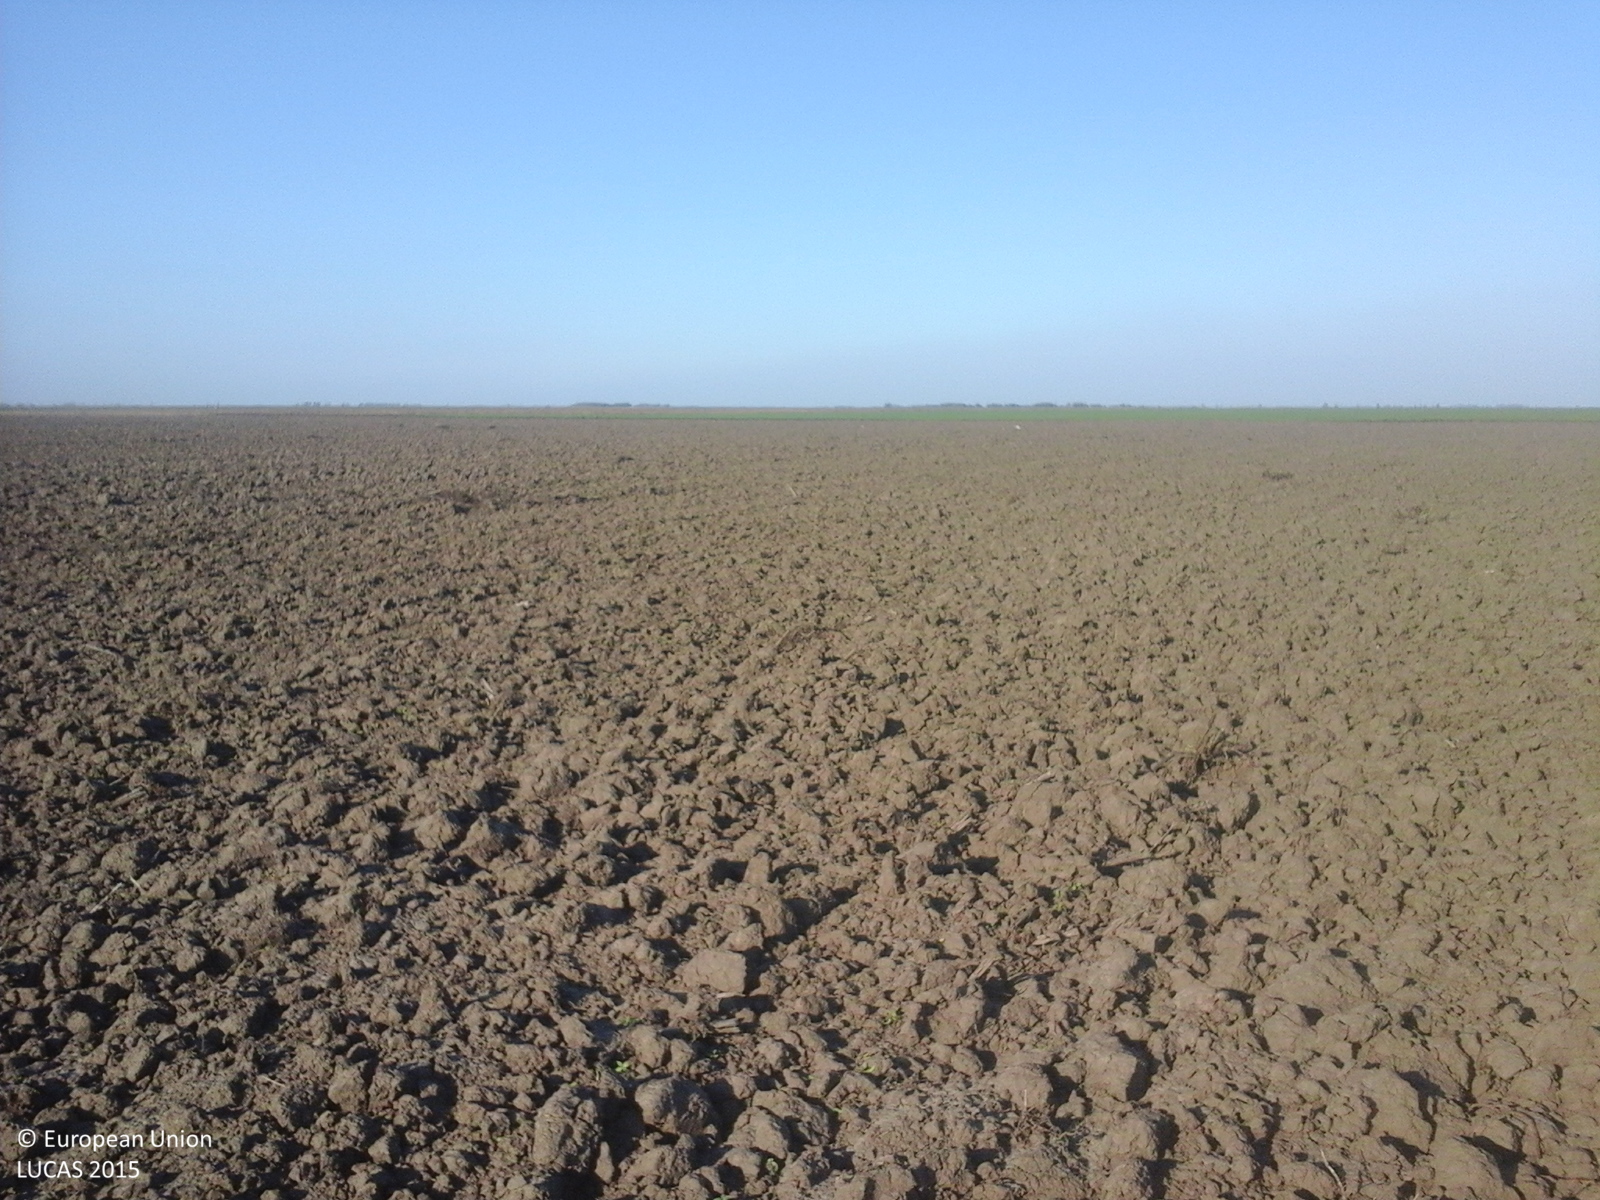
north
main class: Cropland
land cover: Sunflower
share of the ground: < 10 %
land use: Agriculture (excluding fallow land and kitchen gardens)
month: October
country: RO
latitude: 45.2572
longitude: 27.3104
